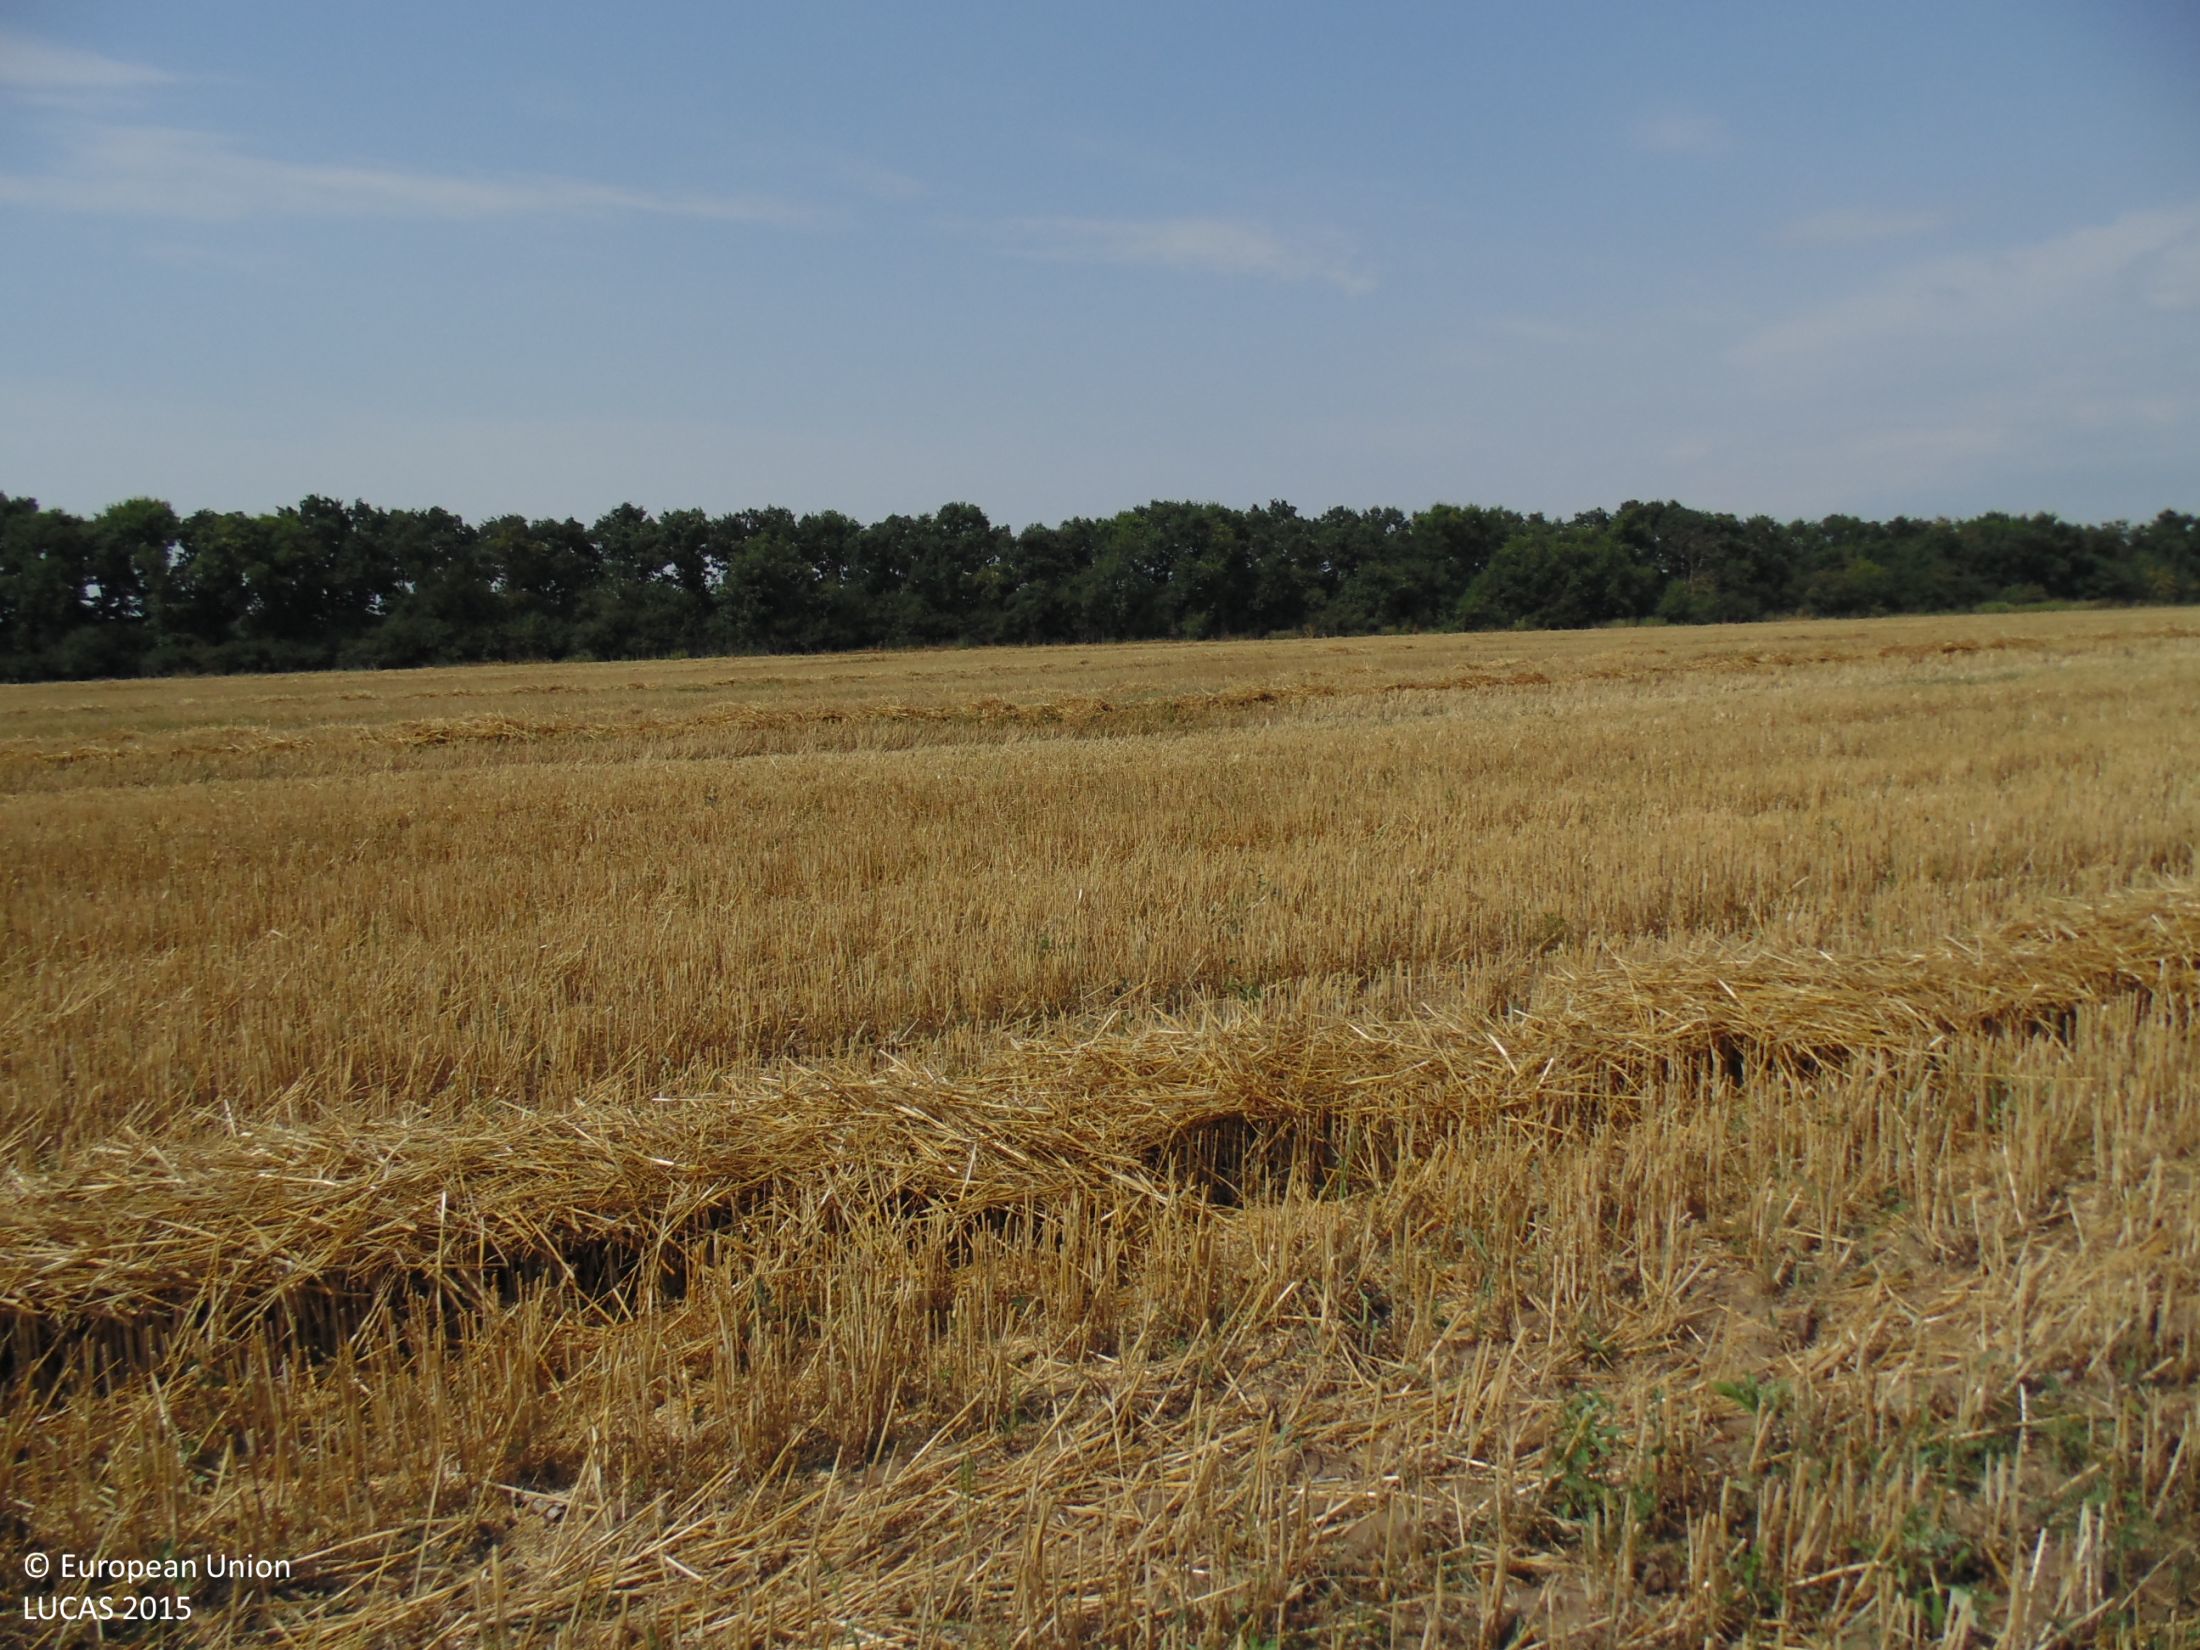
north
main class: Cropland
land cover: Common wheat
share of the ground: 25 - 50 %
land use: Agriculture (excluding fallow land and kitchen gardens)
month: July
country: BG
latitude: 43.6438
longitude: 28.0118
